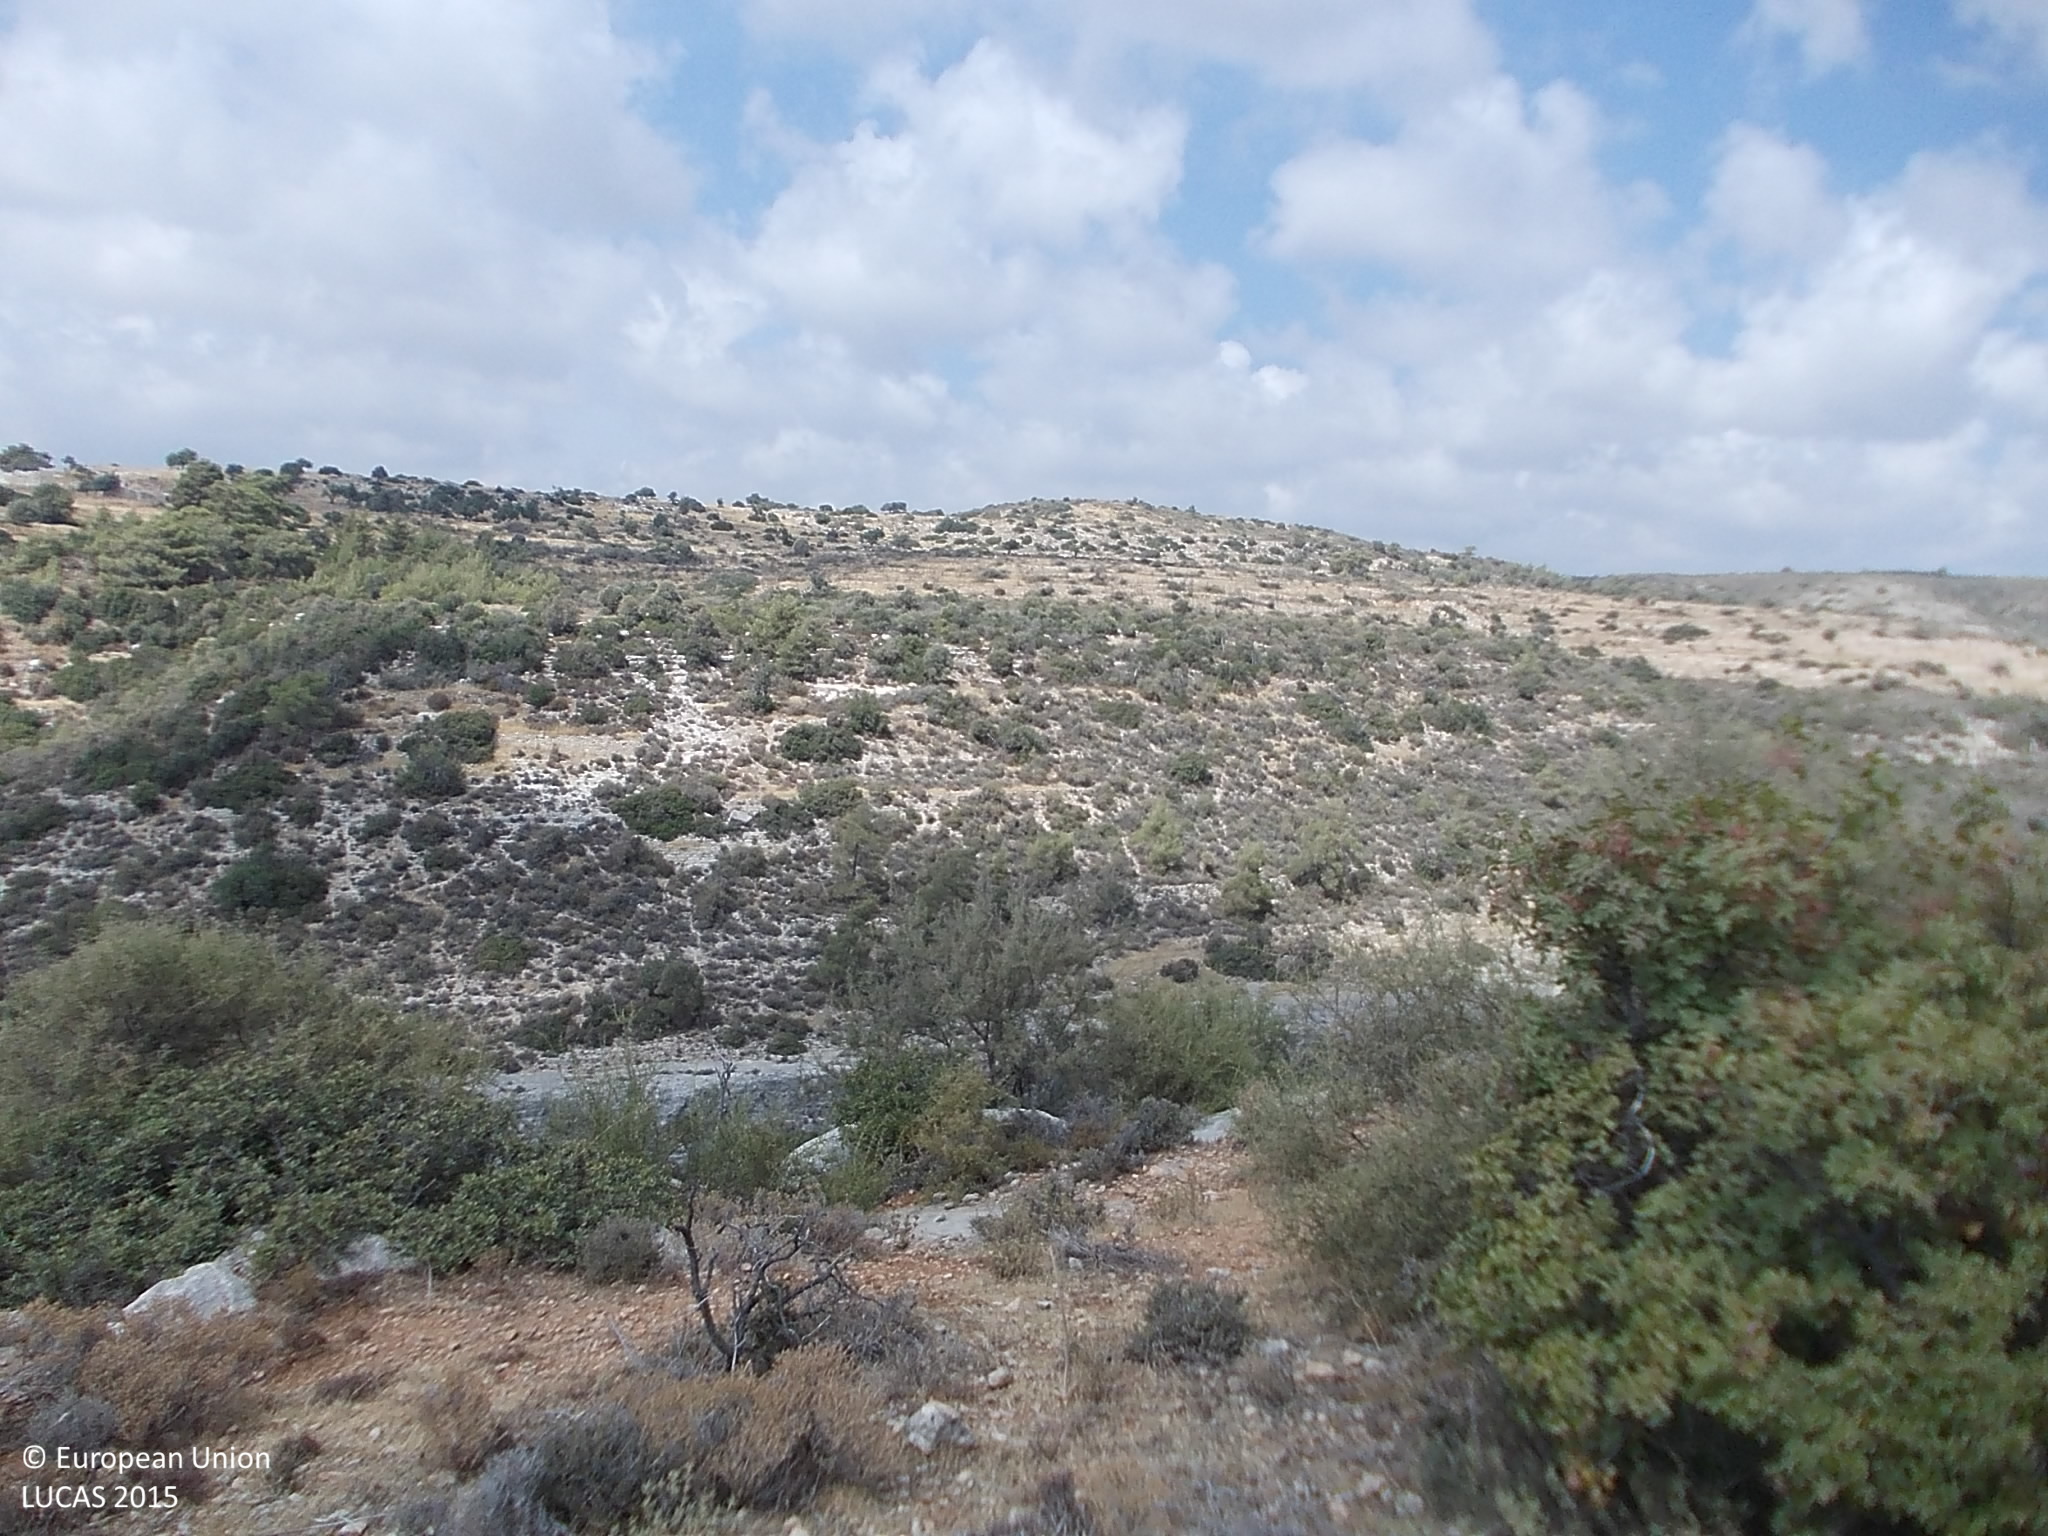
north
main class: Shrubland
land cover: Shrubland with sparse tree cover
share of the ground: 50 - 75 %
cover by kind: shrubs 70 %, unconsolidated bare surface 15 %, herbaceous plants 10 %, broadleaved forest trees 5 %
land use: Semi-natural and natural areas not in use
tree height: < 5 m
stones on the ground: 10 - 25 %
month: September
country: CY
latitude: 34.7278
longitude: 32.8182
